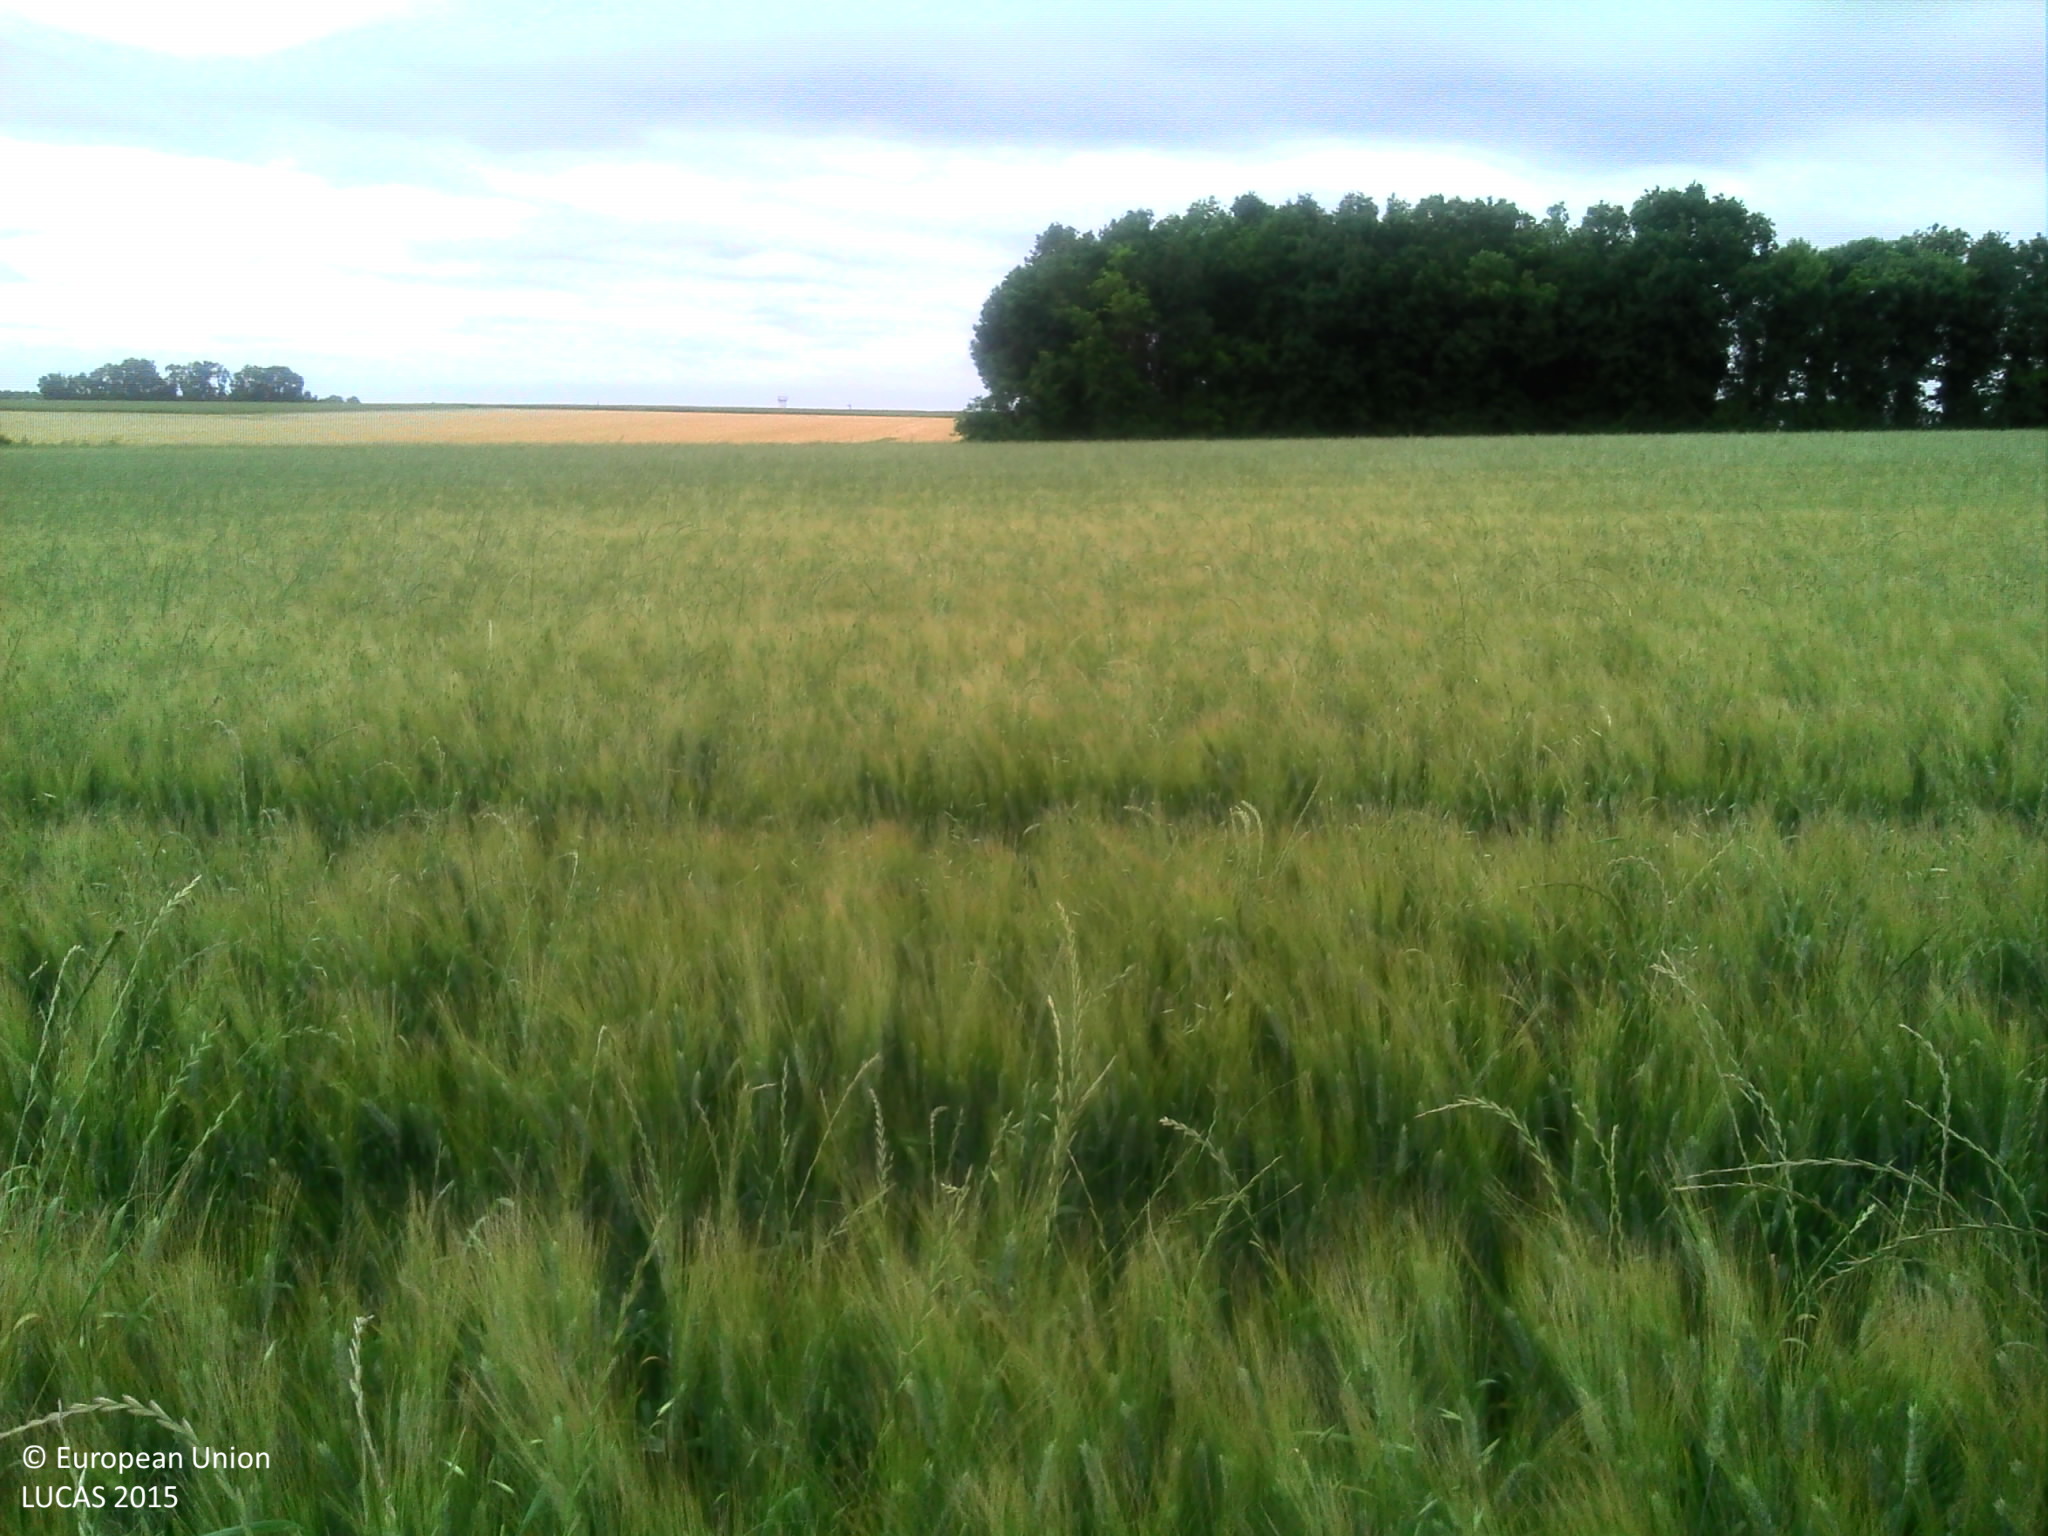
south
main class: Cropland
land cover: Durum wheat
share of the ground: > 75 %
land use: Agriculture (excluding fallow land and kitchen gardens)
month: June
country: FR
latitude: 46.1334
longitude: -0.9408
